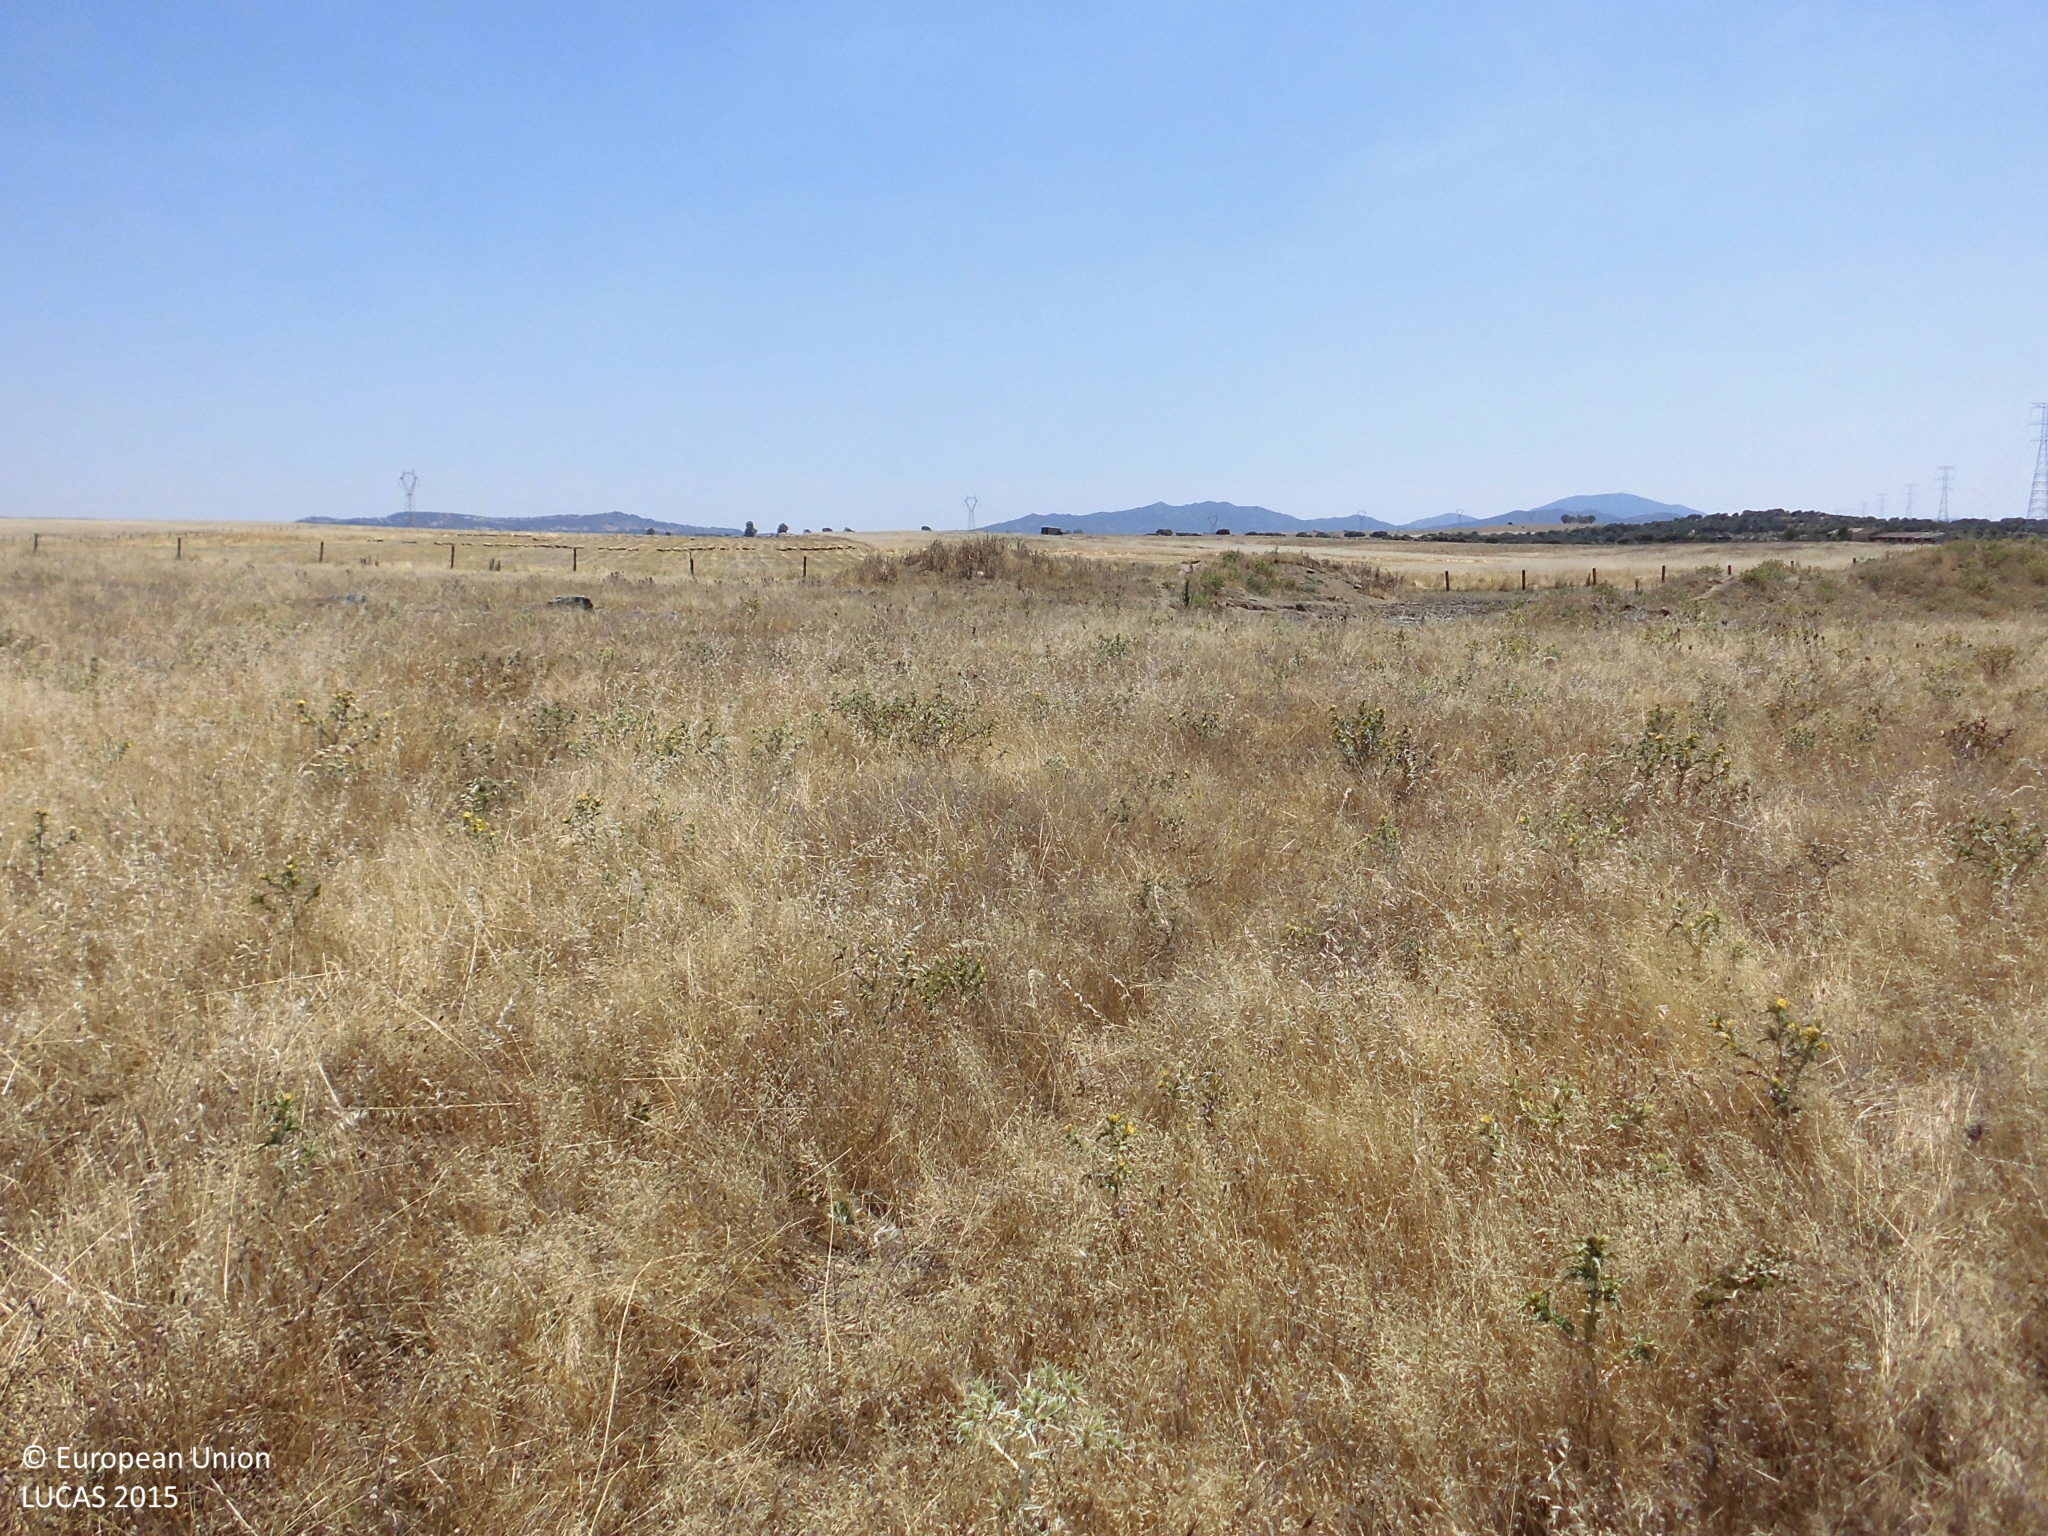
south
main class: Grassland
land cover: Grassland without tree/shrub cover
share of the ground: > 75 %
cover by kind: herbaceous plants 100 %
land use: Agriculture (excluding fallow land and kitchen gardens)
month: June
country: ES
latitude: 39.3725
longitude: -5.9727
